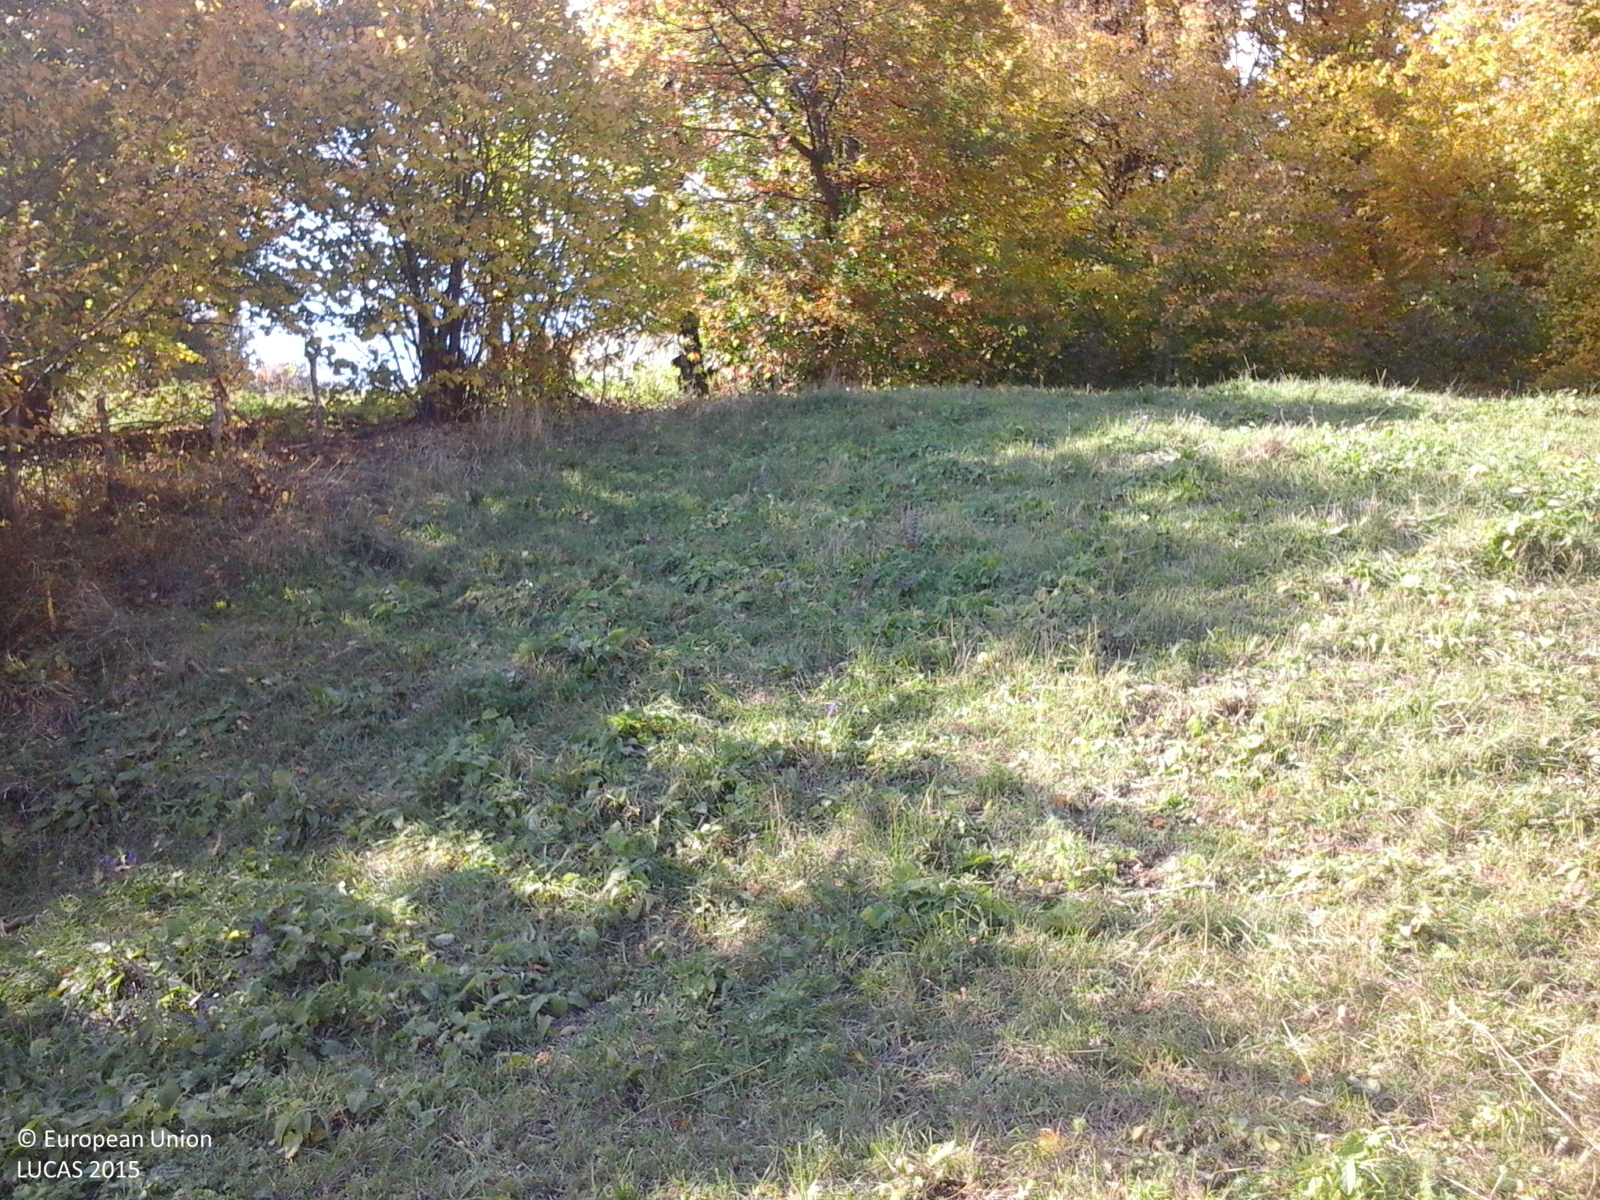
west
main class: Grassland
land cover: Grassland without tree/shrub cover
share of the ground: > 75 %
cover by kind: herbaceous plants 100 %
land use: Agriculture (excluding fallow land and kitchen gardens)
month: October
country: RO
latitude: 45.5195
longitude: 26.6047
